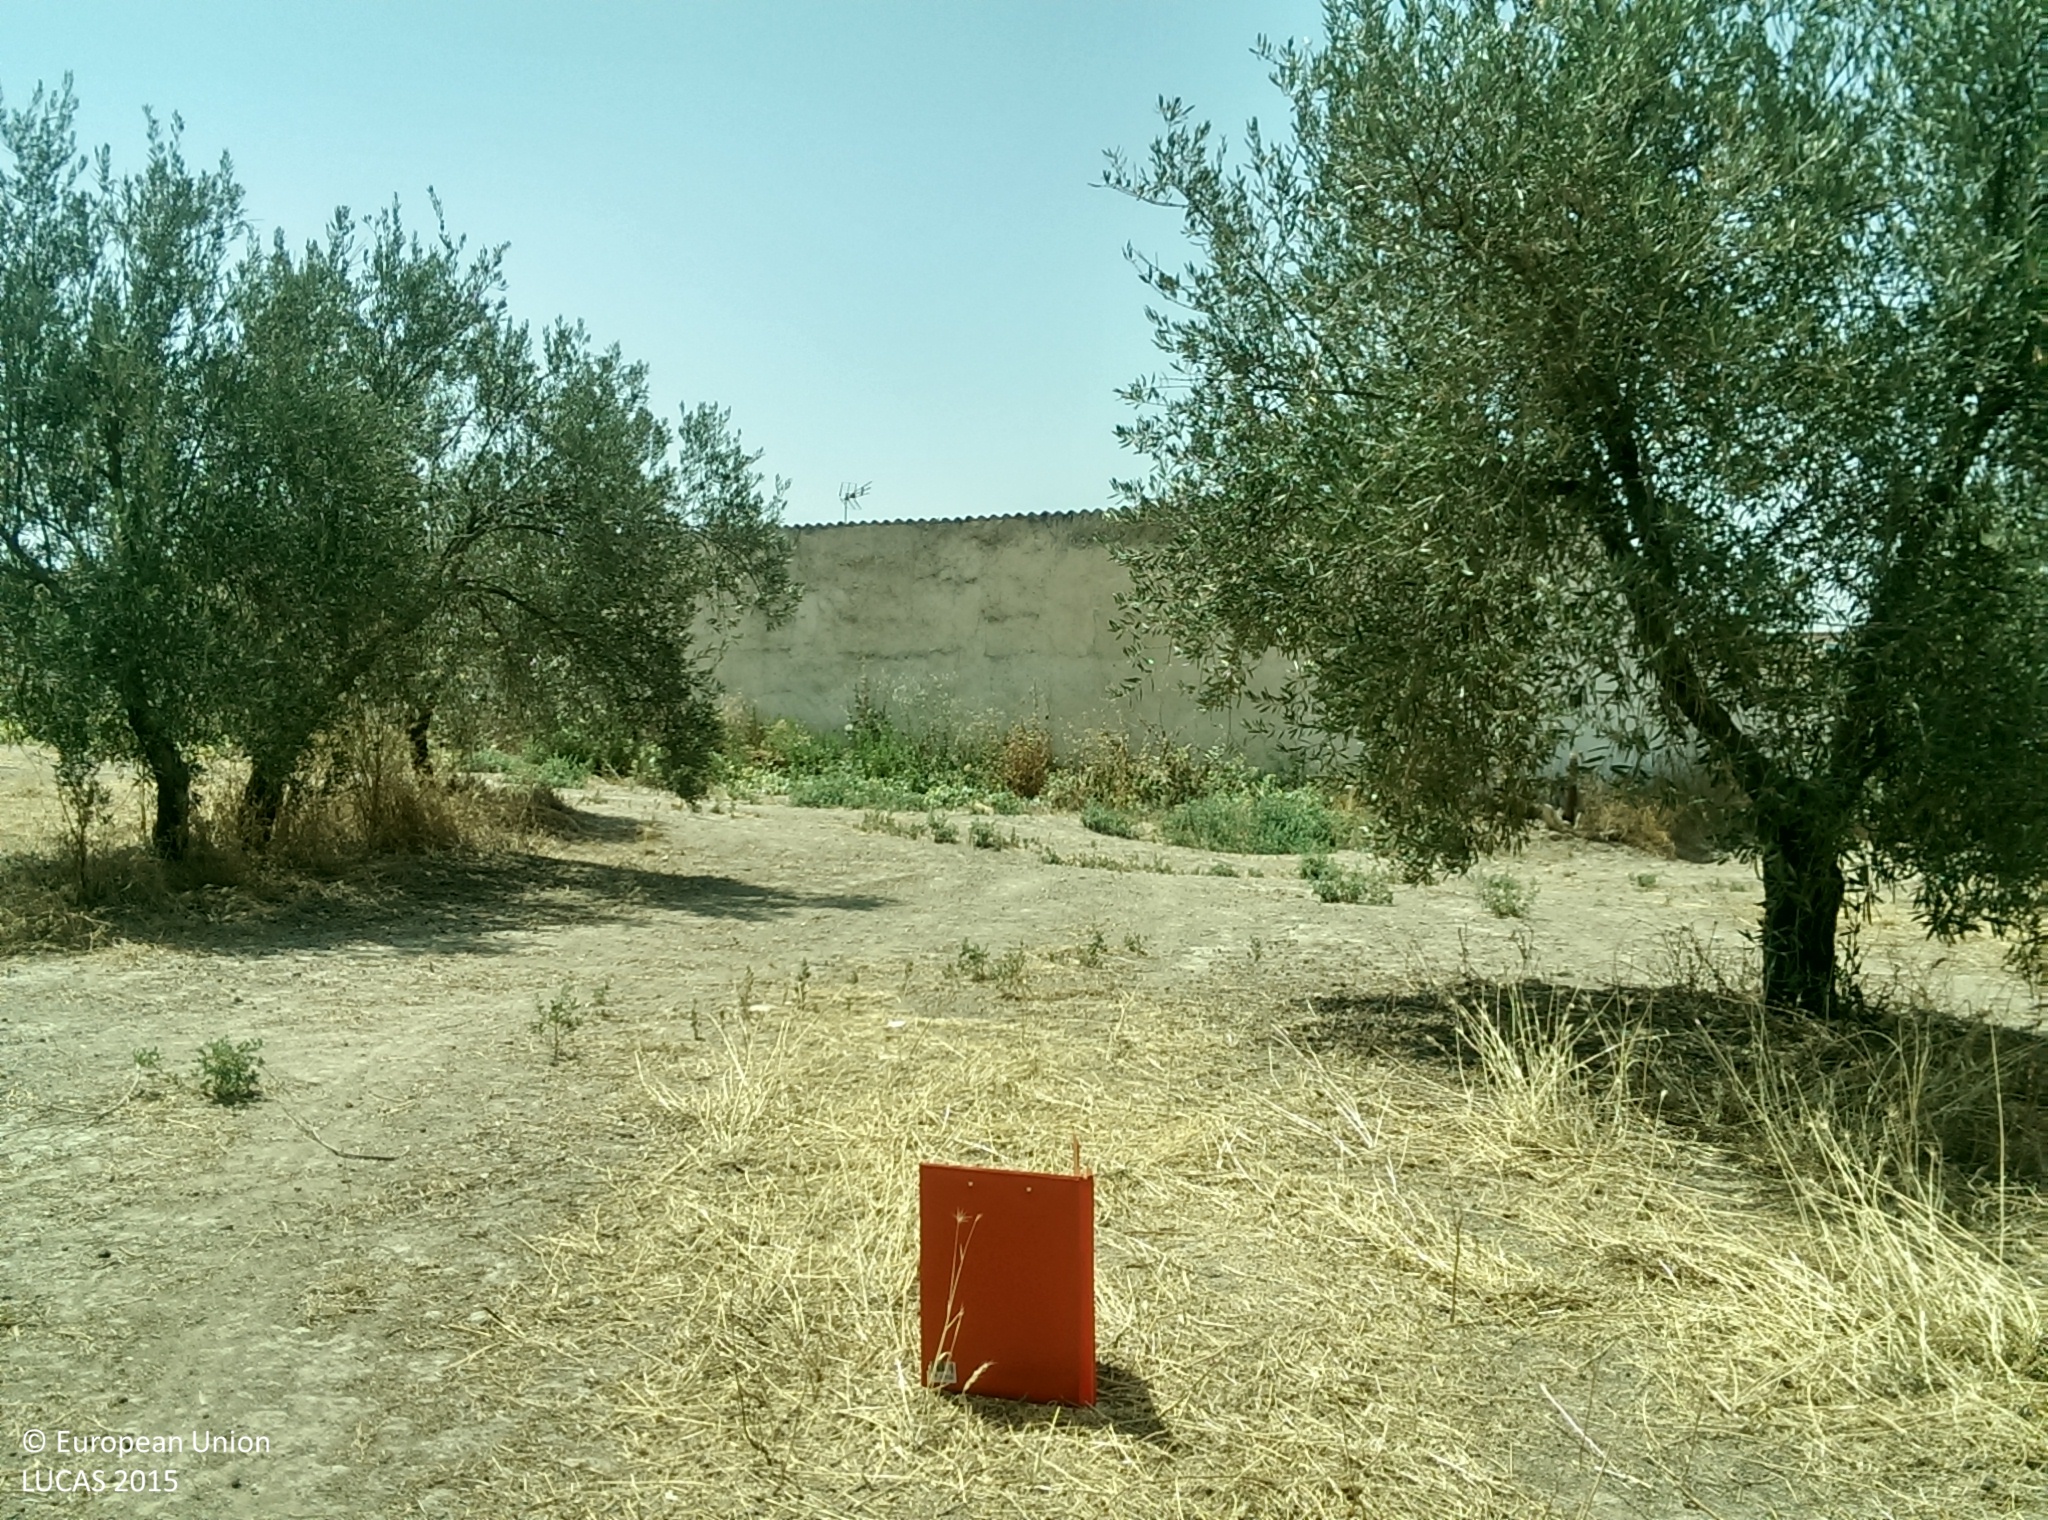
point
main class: Cropland
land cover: Olive groves
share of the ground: 25 - 50 %
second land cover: Spontaneously vegetated surfaces
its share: > 75 %
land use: Agriculture (excluding fallow land and kitchen gardens)
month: July
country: ES
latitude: 37.2273
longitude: -3.7075
